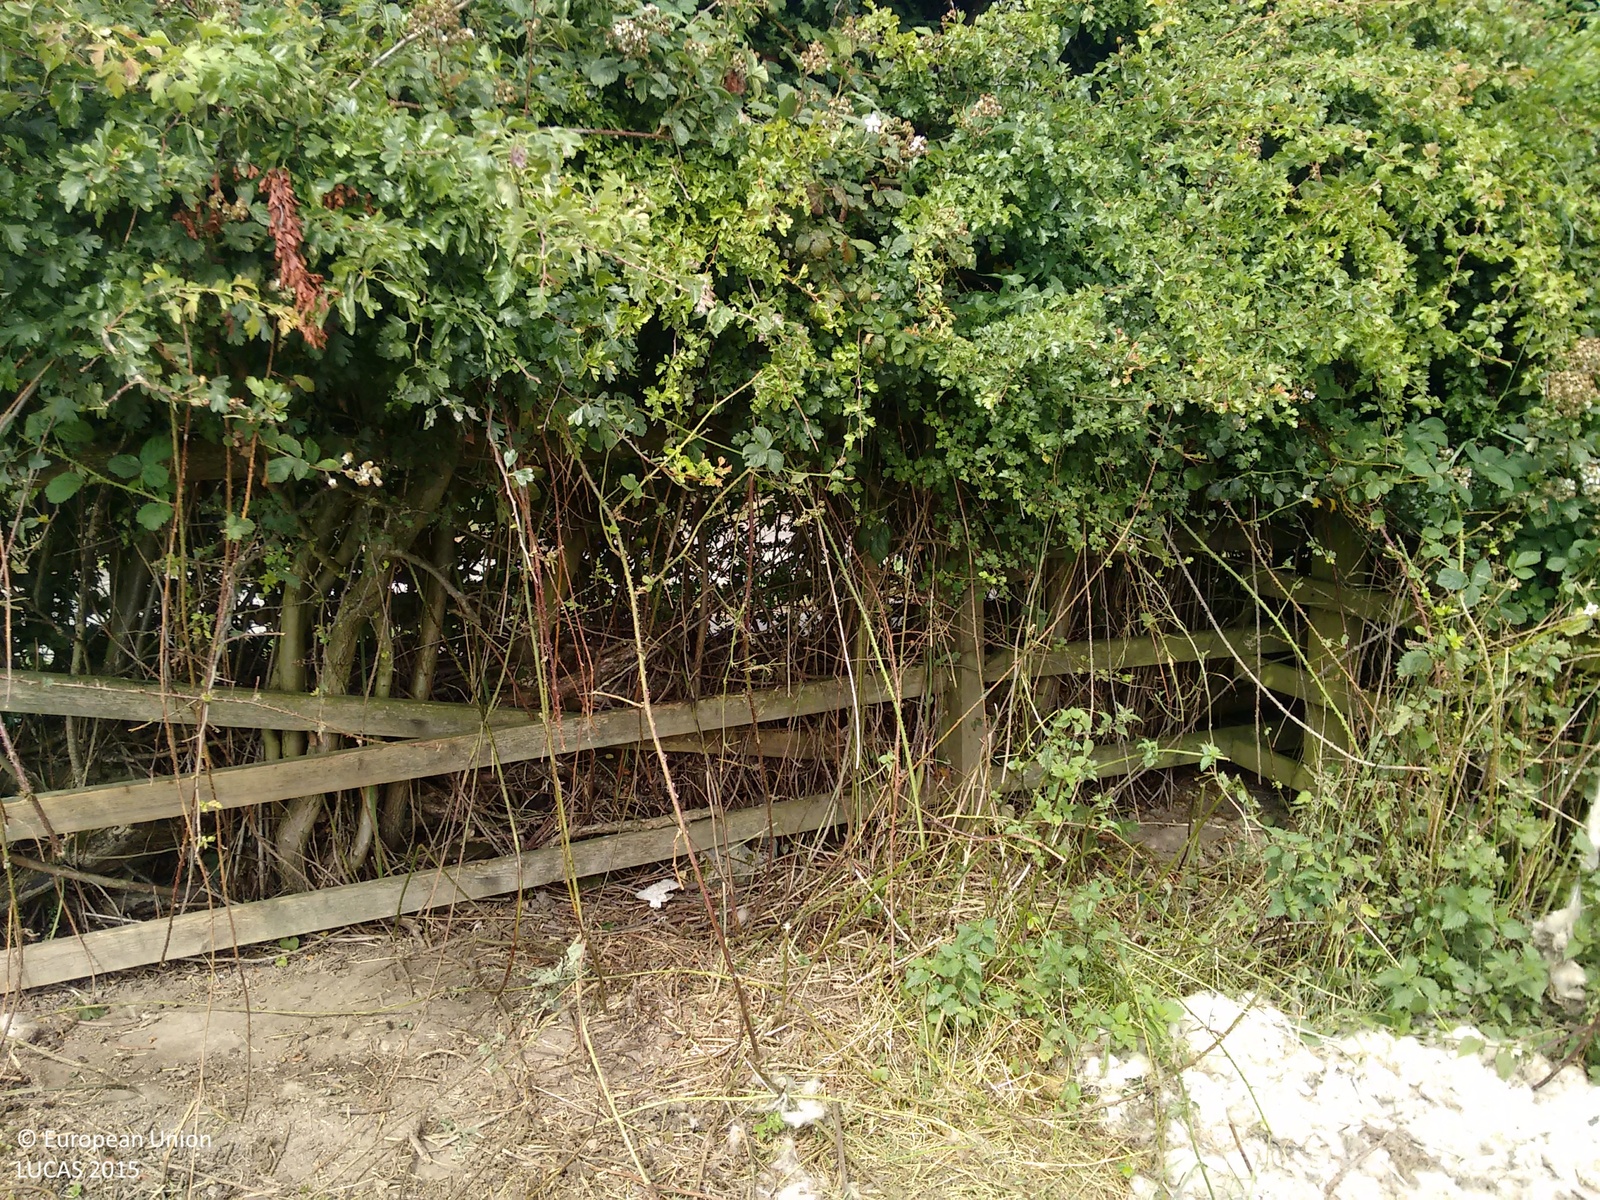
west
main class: Grassland
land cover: Grassland without tree/shrub cover
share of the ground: > 75 %
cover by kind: herbaceous plants 100 %
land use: Agriculture (excluding fallow land and kitchen gardens)
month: July
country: GB
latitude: 53.0227
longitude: -1.4246
